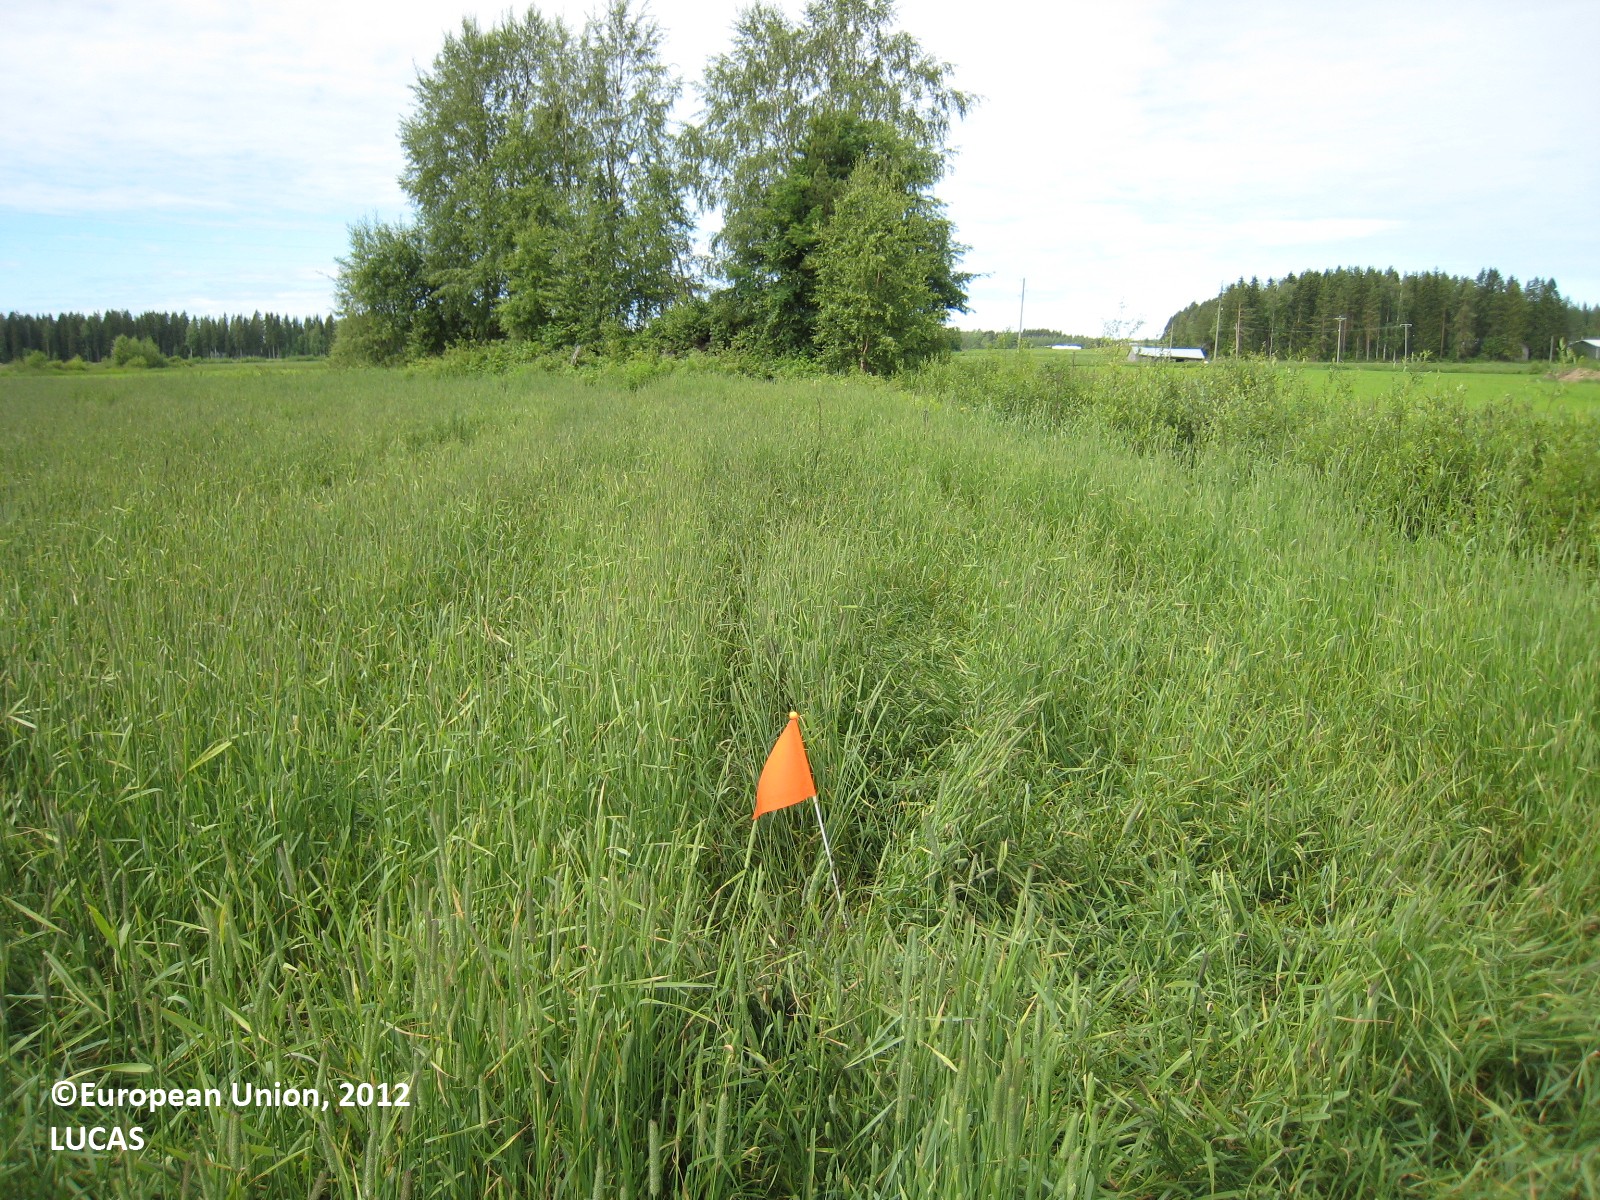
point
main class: Cropland
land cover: Temporary grasslands
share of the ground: > 75 %
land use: Agriculture (excluding fallow land and kitchen gardens)
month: June
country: FI
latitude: 62.3960
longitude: 26.3258
